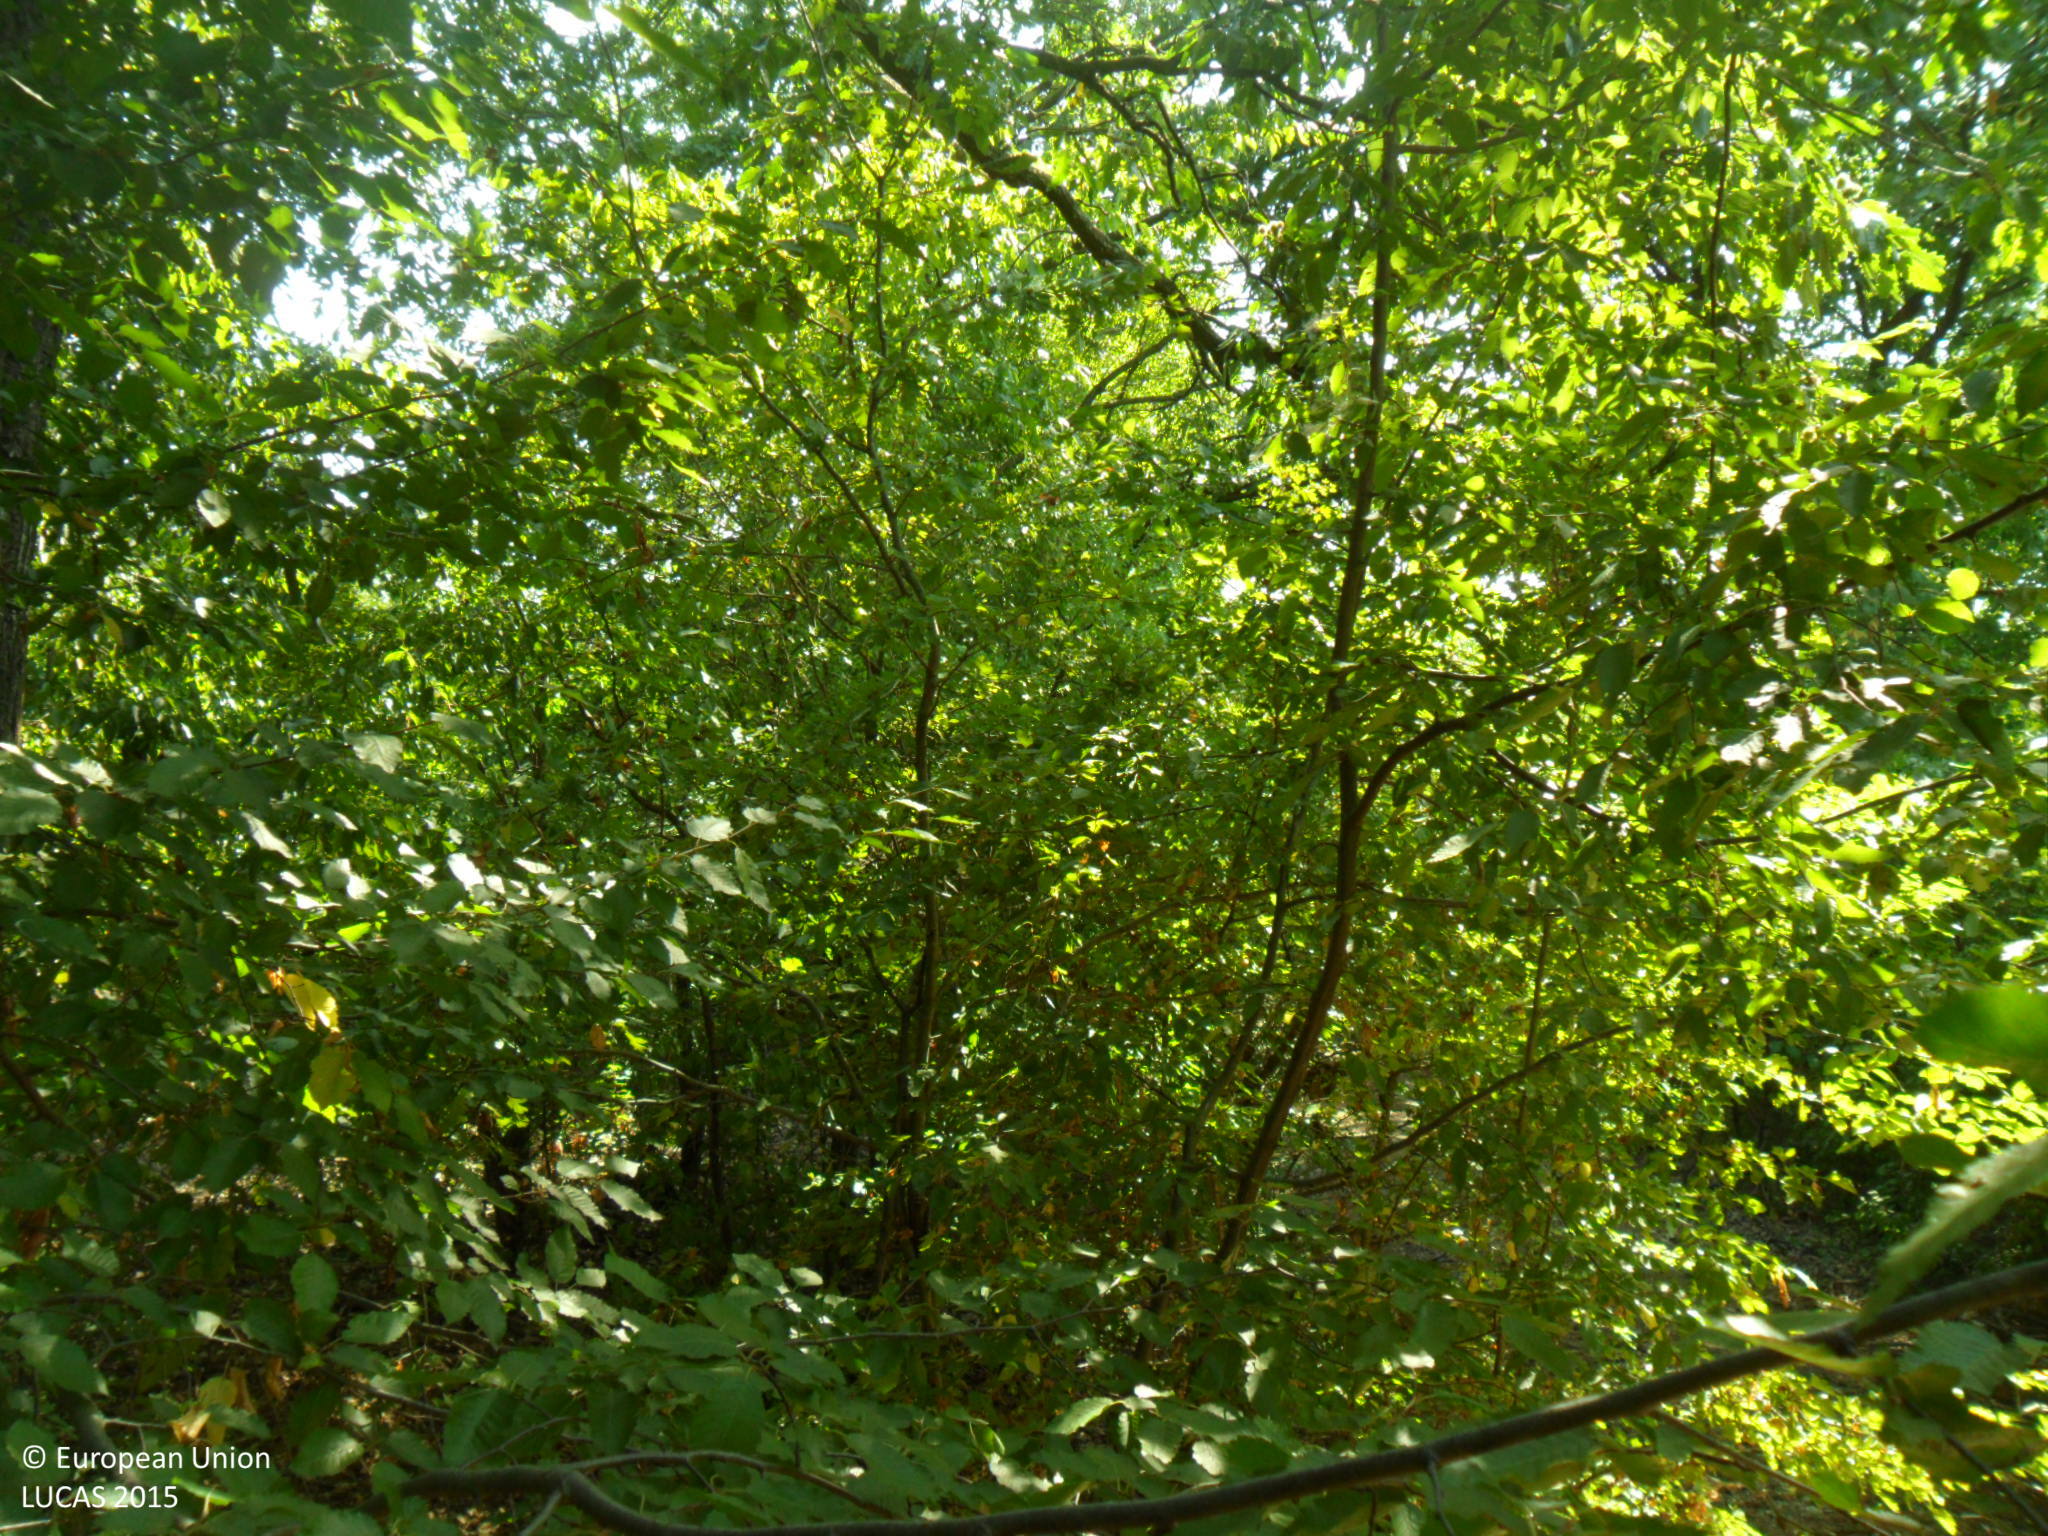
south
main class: Woodland
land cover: Broadleaved woodland
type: beech forest
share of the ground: > 75 %
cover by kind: broadleaved forest trees 90 %, herbaceous plants 10 %
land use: Forestry
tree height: > 5 m
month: August
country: BG
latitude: 43.5985
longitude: 27.1048
